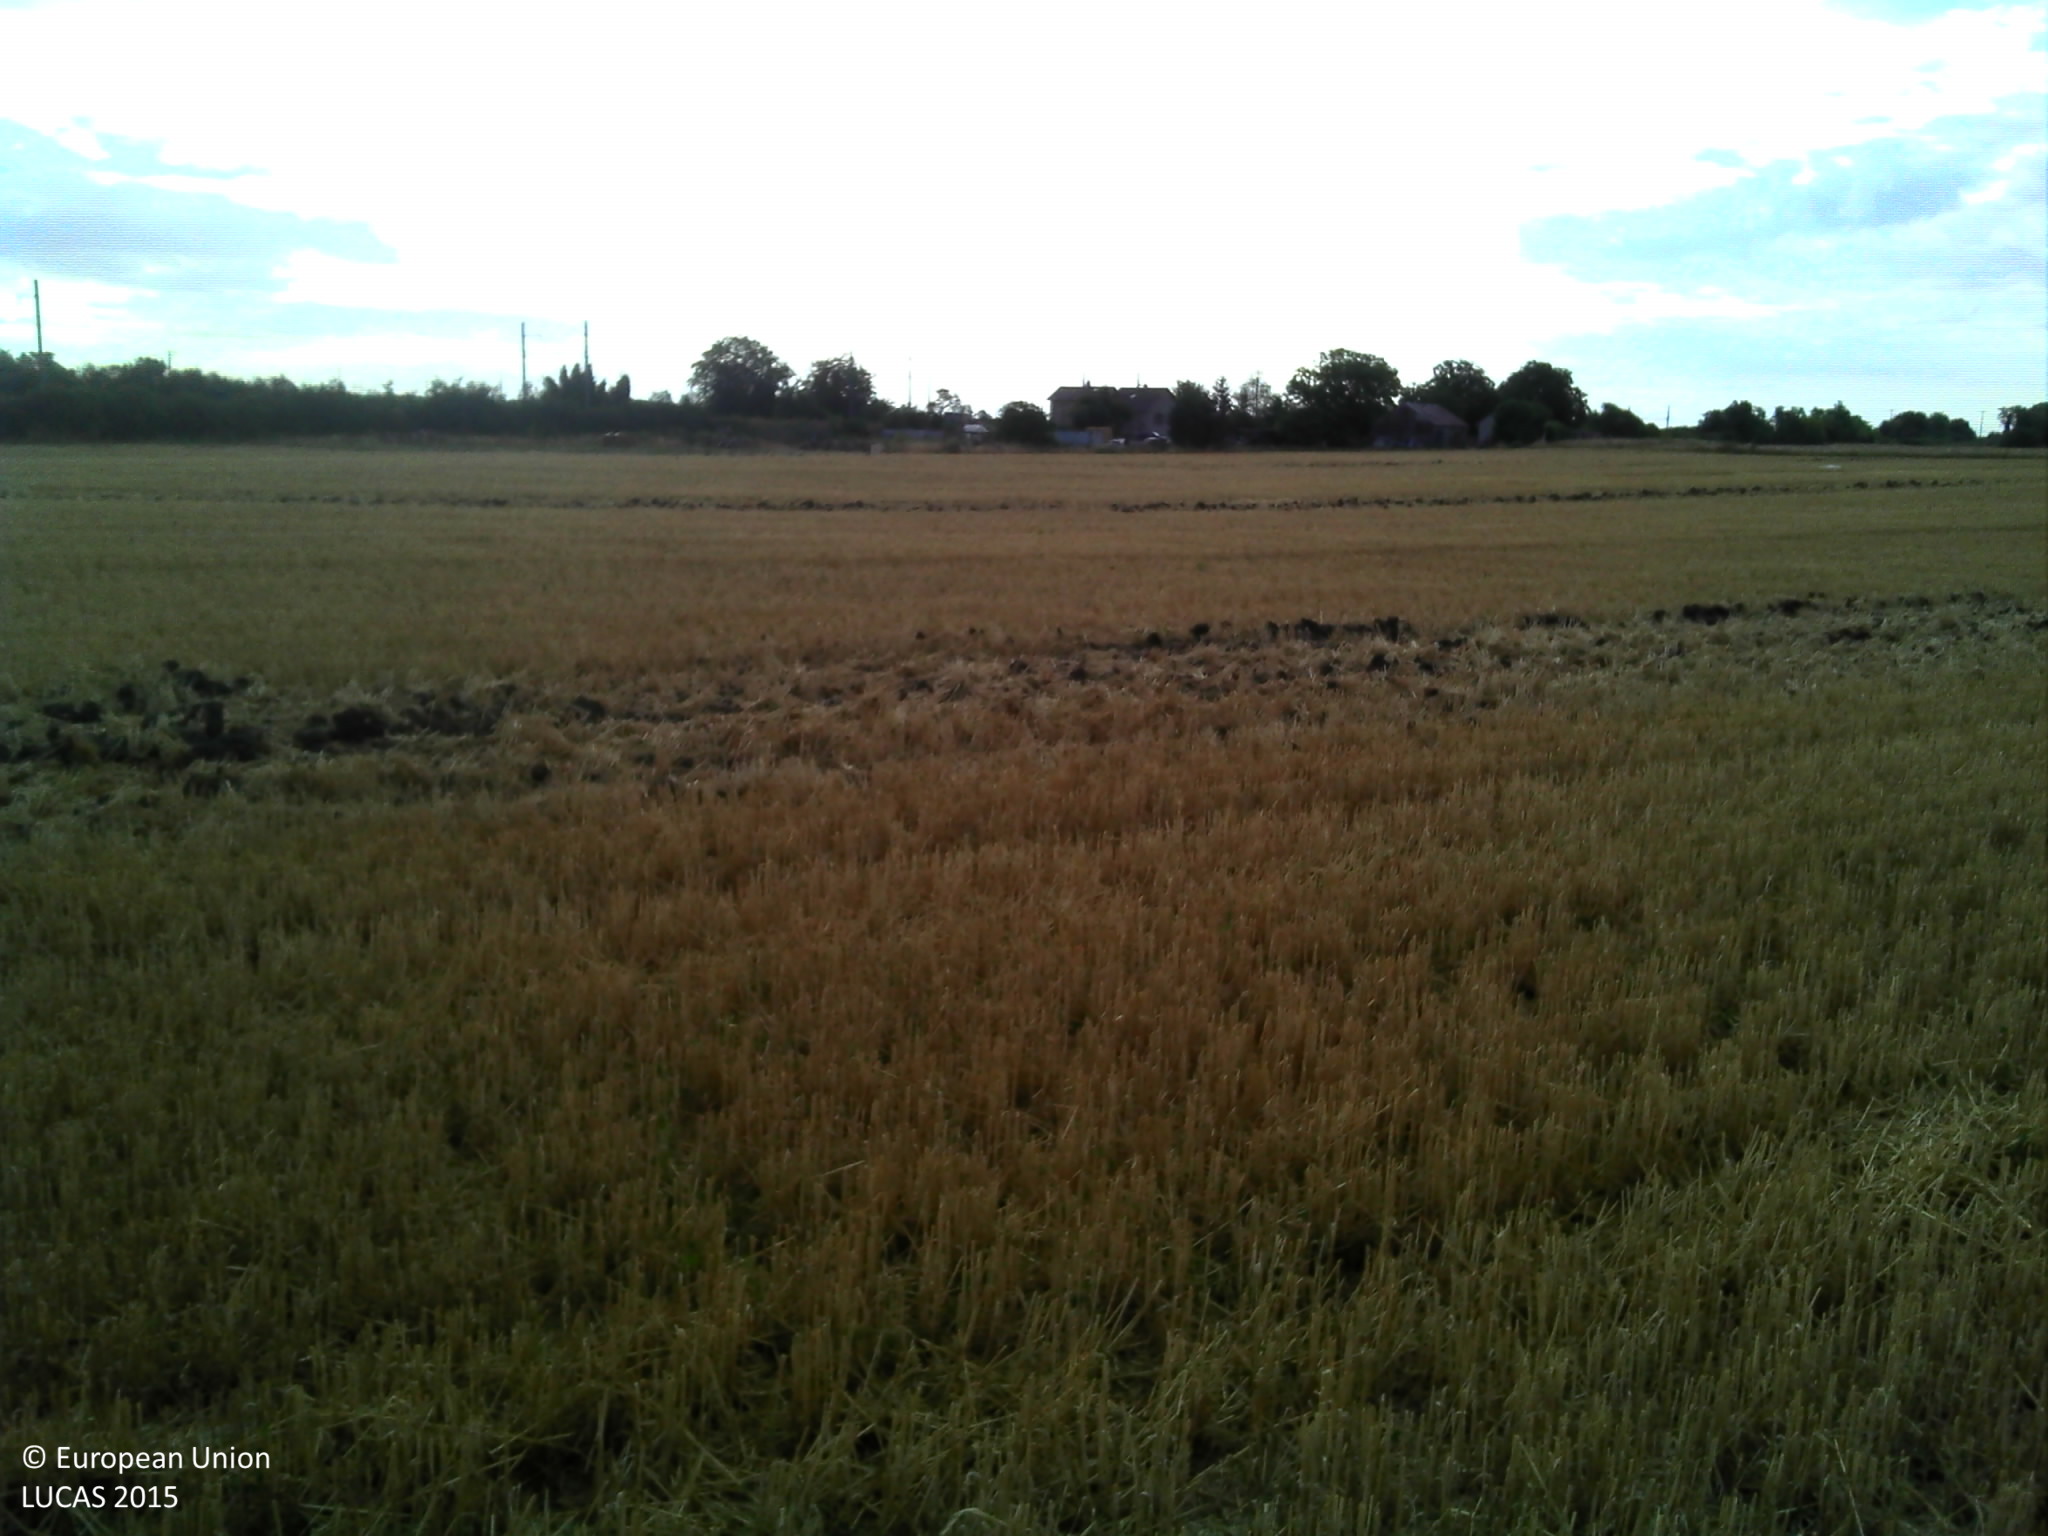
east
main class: Cropland
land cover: Barley
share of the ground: > 75 %
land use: Agriculture (excluding fallow land and kitchen gardens)
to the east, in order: Barley; Spontaneously vegetated surfaces; Artificial constructions in urban areas
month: July
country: FR
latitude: 47.1173
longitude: 2.2287
